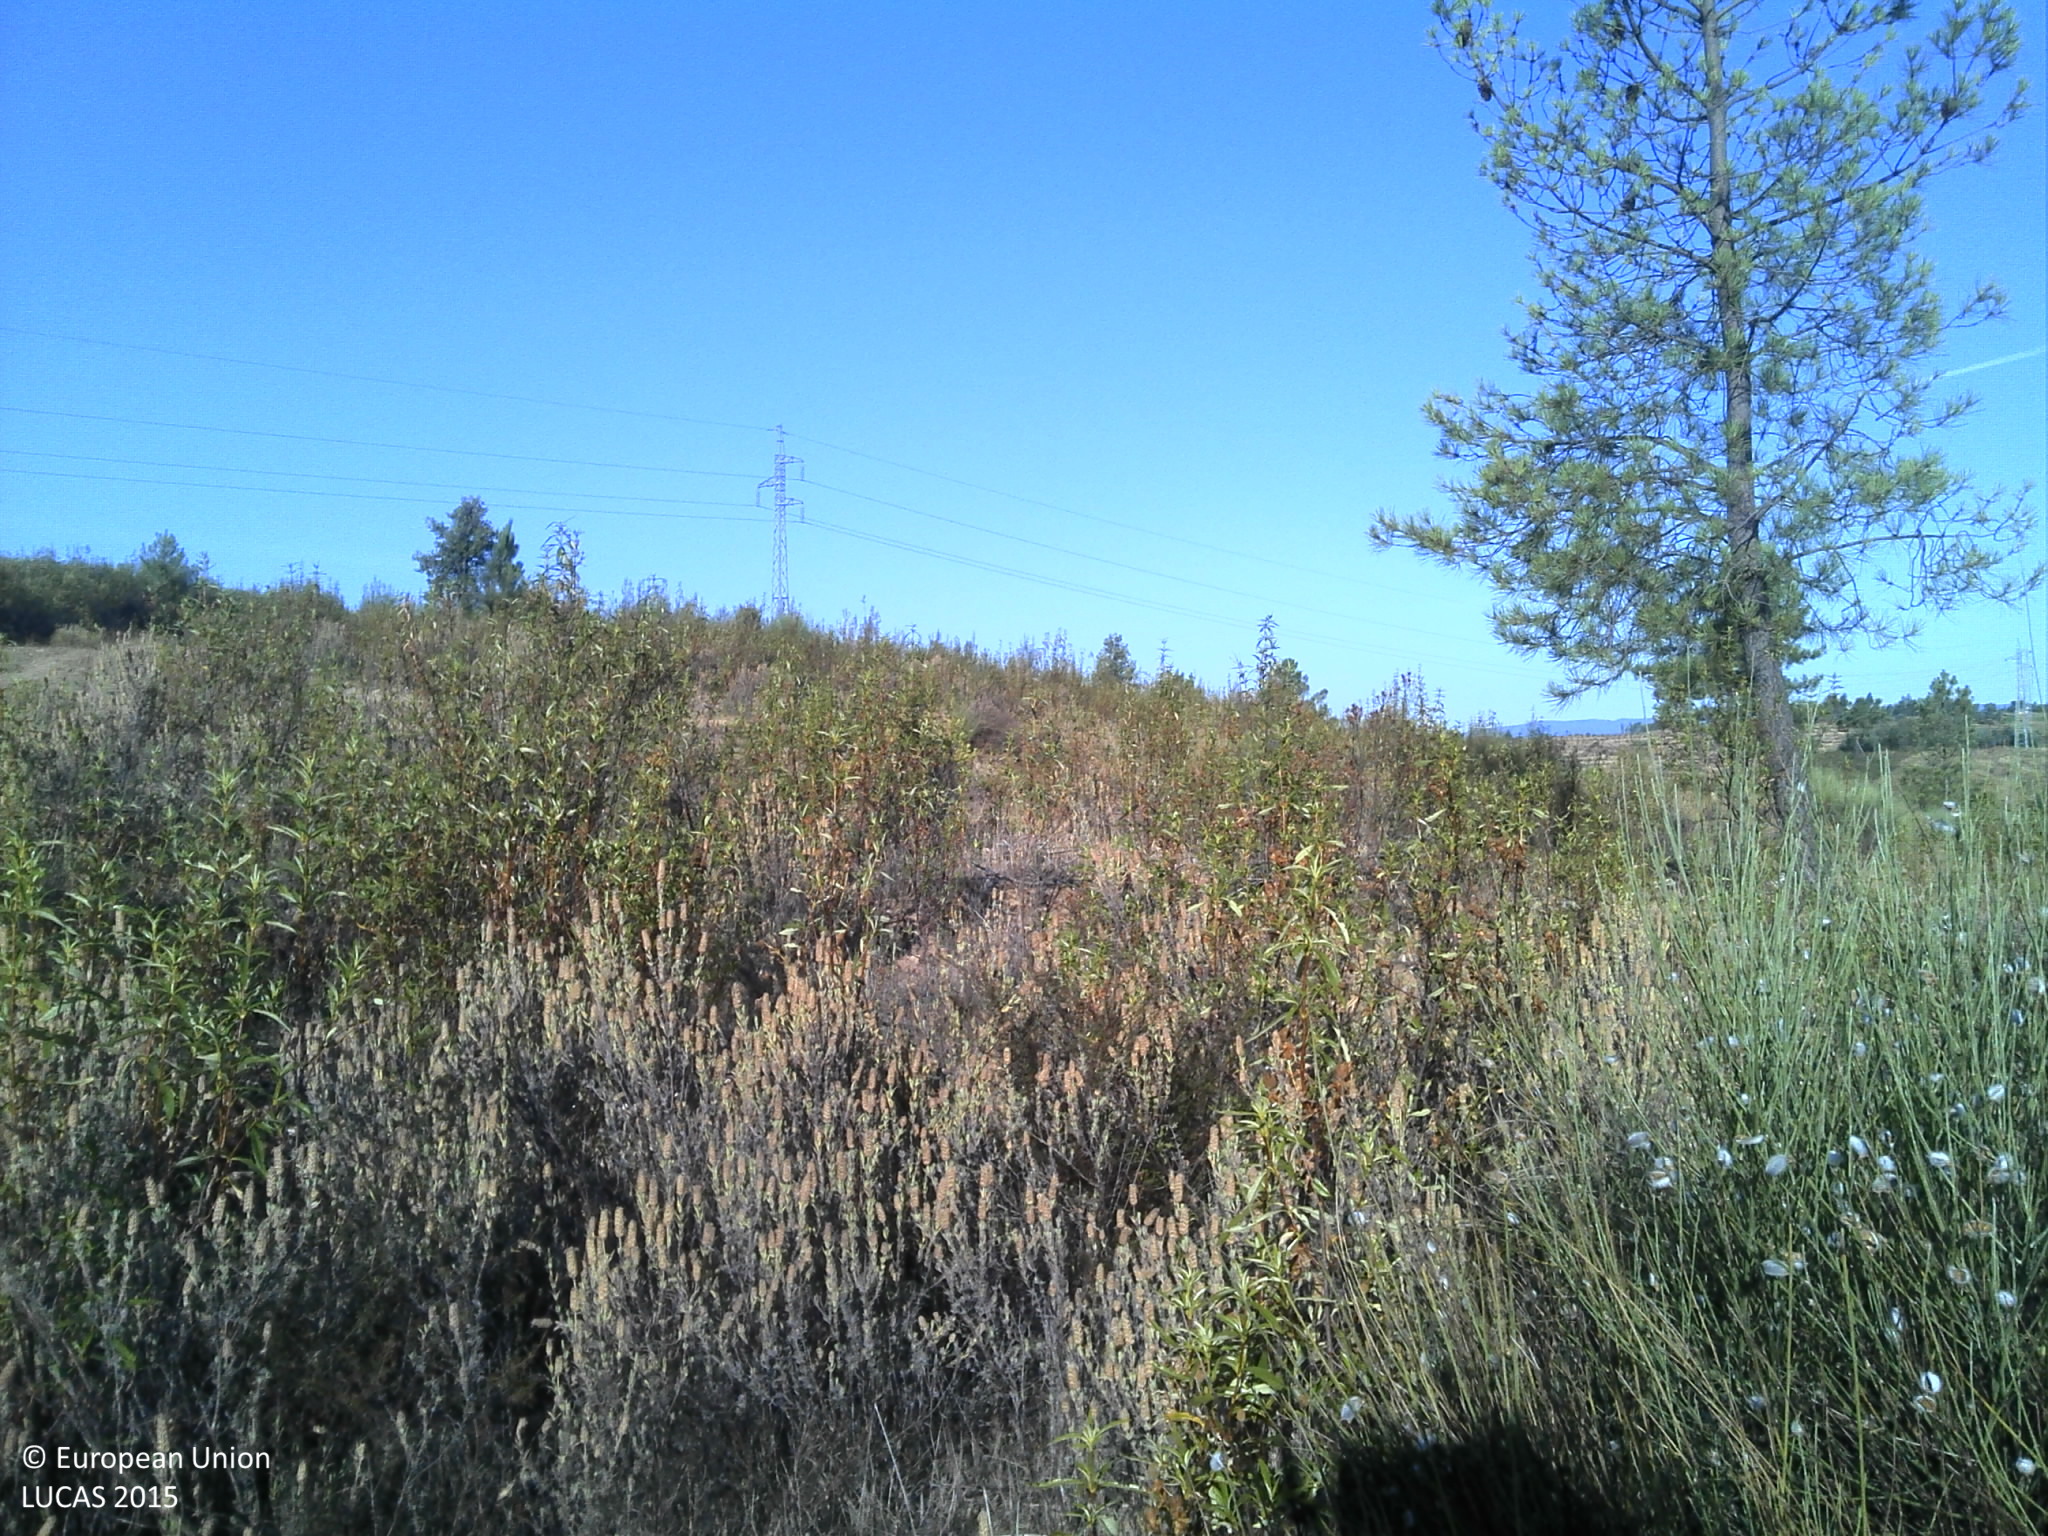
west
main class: Shrubland
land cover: Shrubland without tree cover
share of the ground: 50 - 75 %
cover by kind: shrubs 65 %, unconsolidated bare surface 15 %, herbaceous plants 10 %
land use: Semi-natural and natural areas not in use
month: July
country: PT
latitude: 39.8309
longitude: -7.5694
